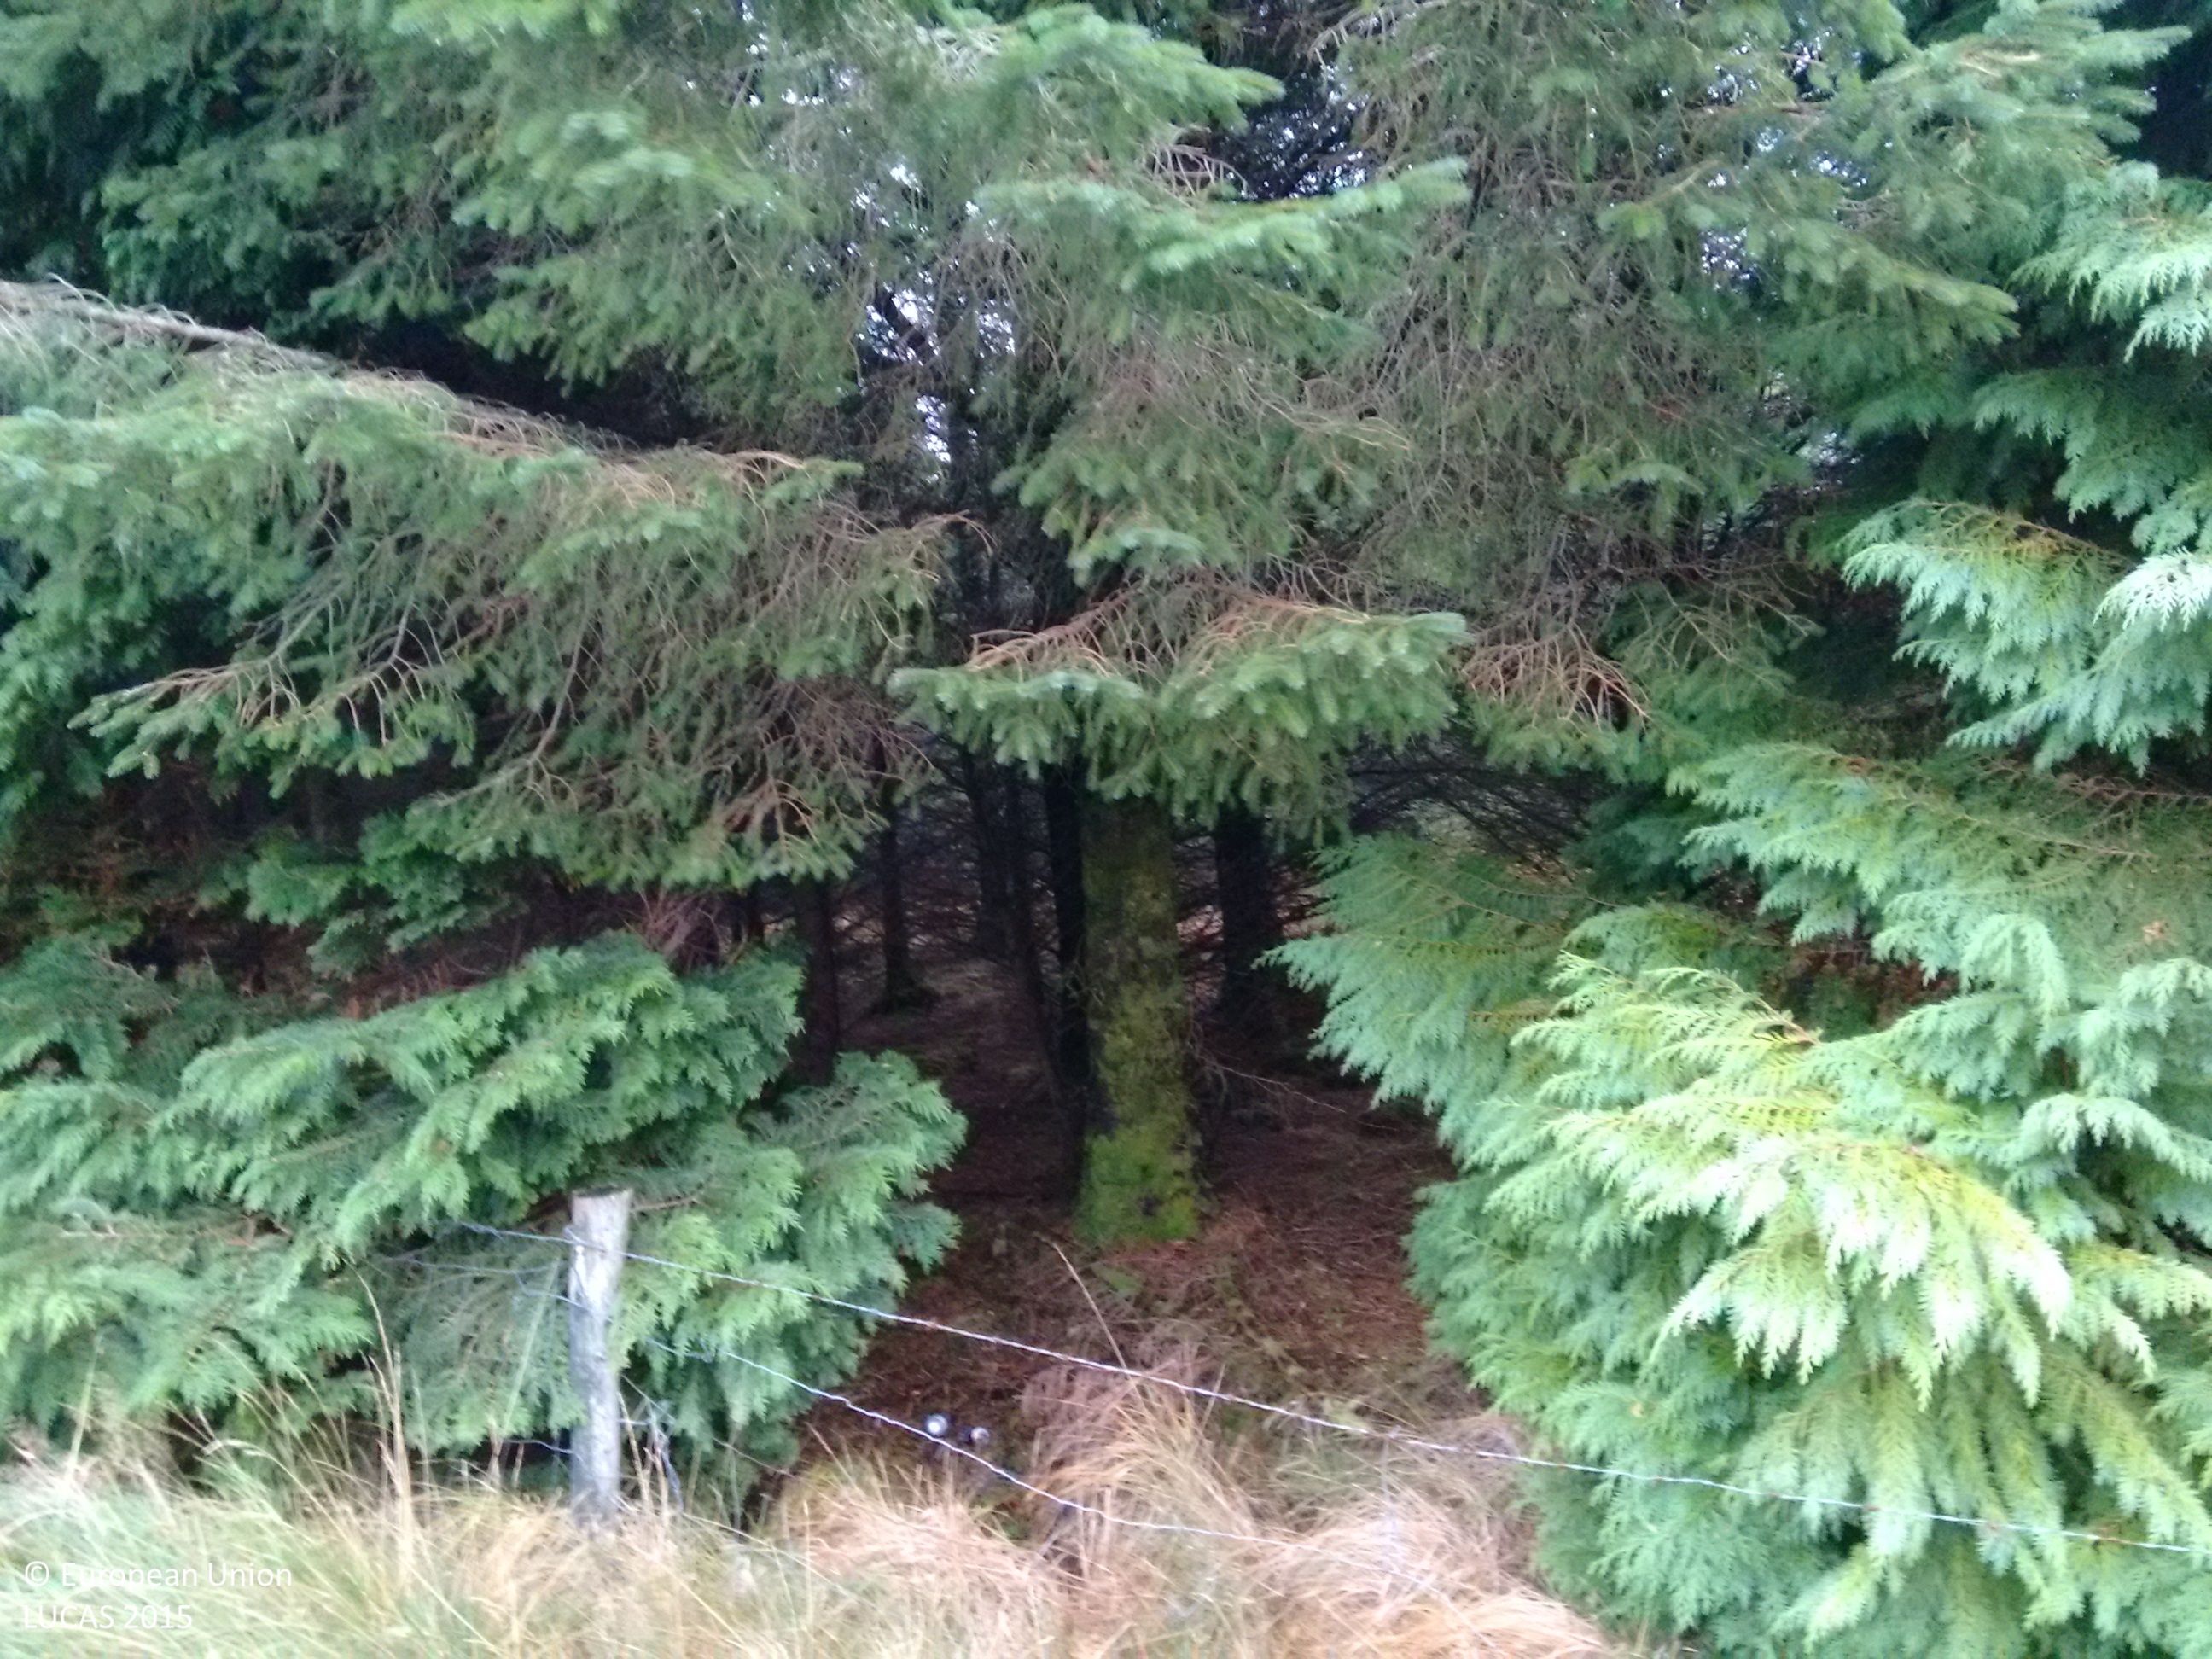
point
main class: Woodland
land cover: Spruce dominated coniferous woodland
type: exotic forest
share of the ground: > 75 %
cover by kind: coniferous forest trees 90 %, herbaceous plants 10 %
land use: Forestry
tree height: > 5 m
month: November
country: IE
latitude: 54.8239
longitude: -8.2517
